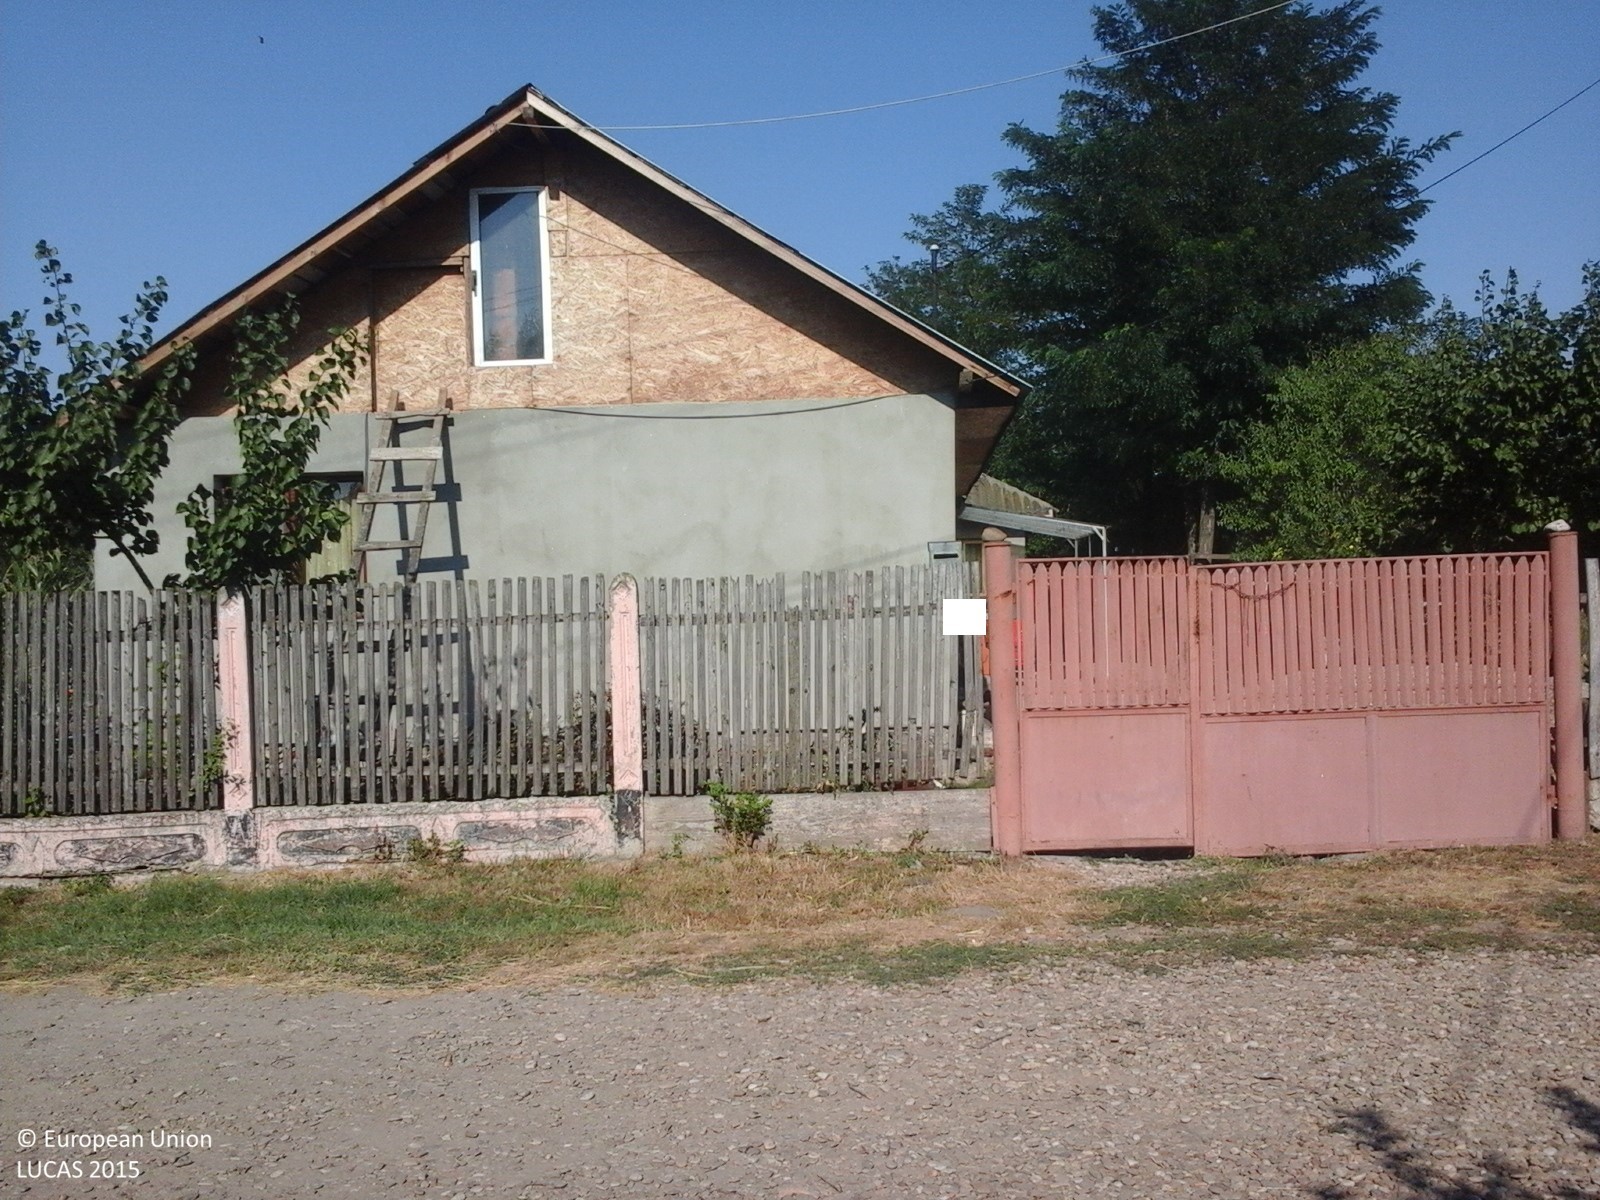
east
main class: Grassland
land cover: Grassland with sparse tree/shrub cover
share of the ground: > 75 %
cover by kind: herbaceous plants 90 %, broadleaved forest trees 5 %, shrubs 5 %
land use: Agriculture (excluding fallow land and kitchen gardens)
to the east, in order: Grassland with sparse tree/shrub cover; Artificial constructions in urban areas; Broadleaved woodland; Arable land (only in case pi); Artificial constructions in urban areas; Arable land (only in case pi); Abandoned hedges; Arable land (only in case pi); Artificial constructions in urban areas
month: August
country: RO
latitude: 45.0807
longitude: 26.7053
